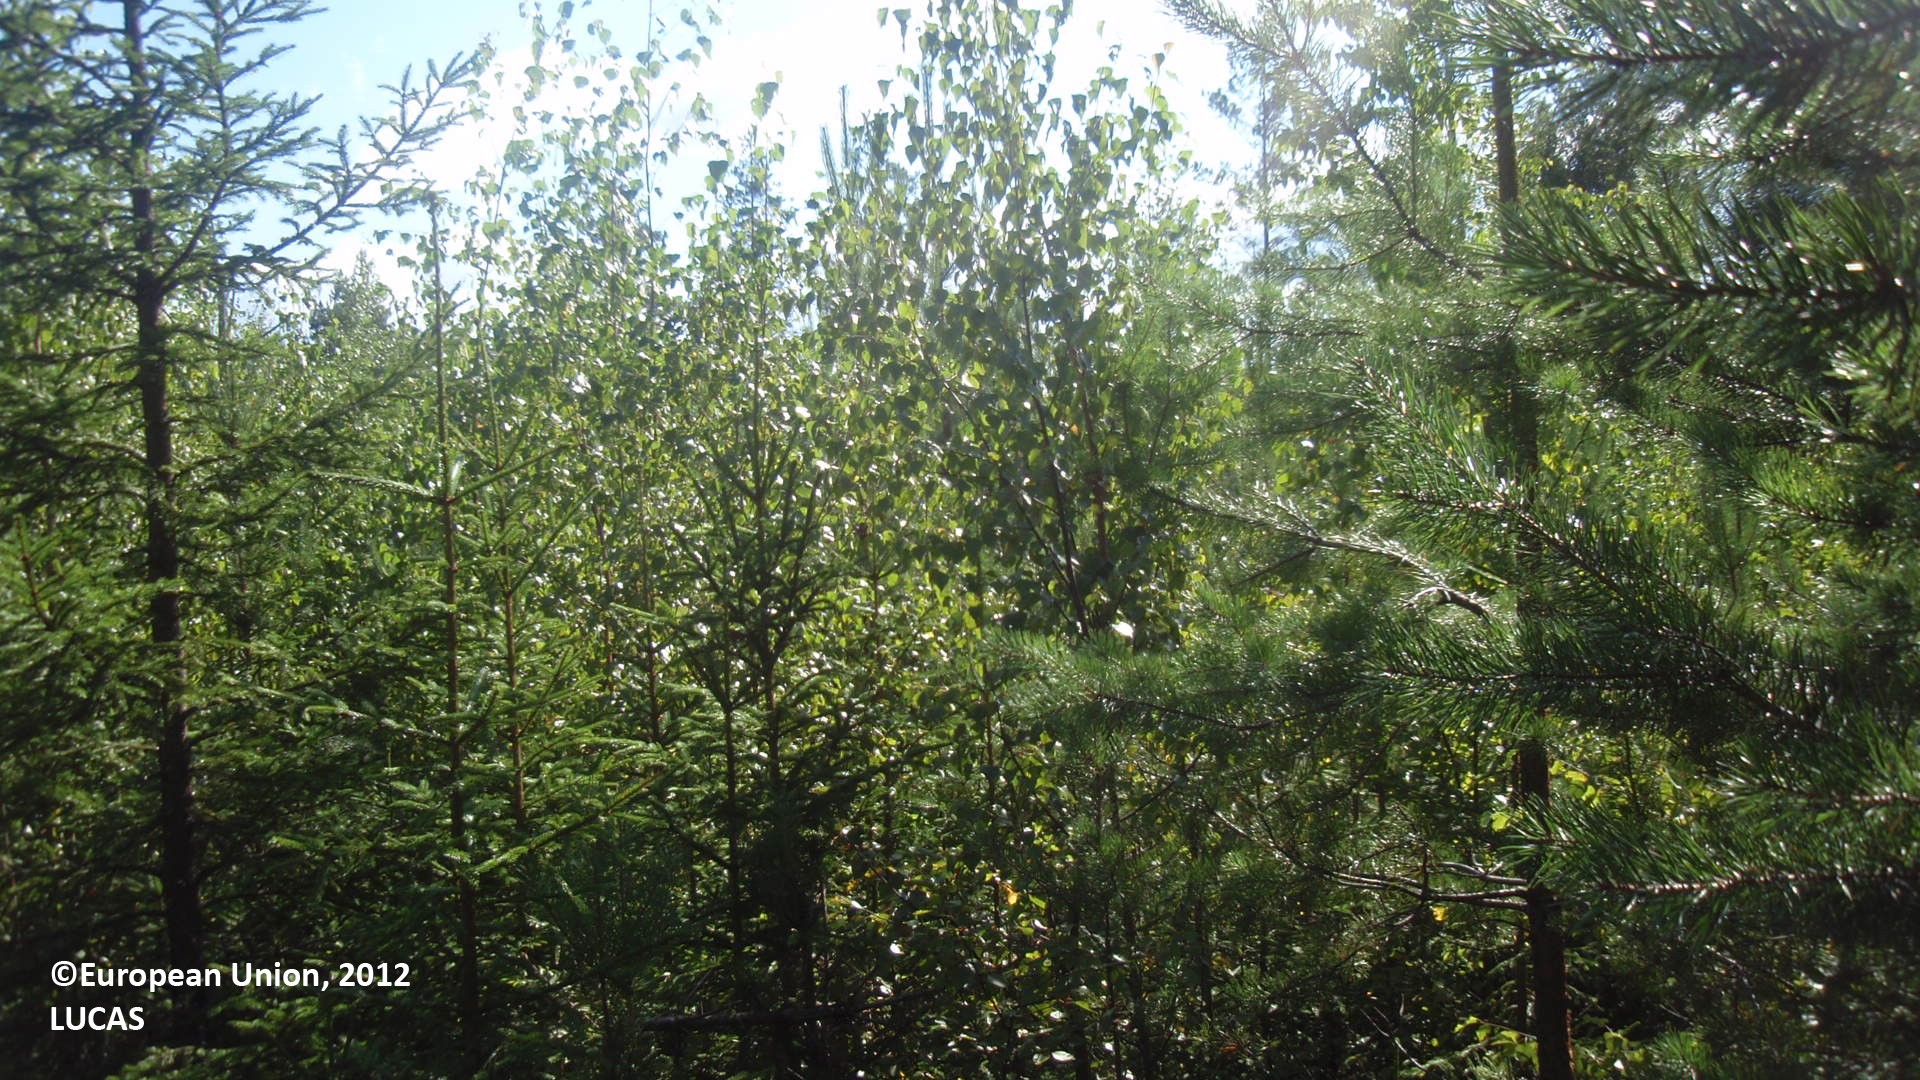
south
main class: Woodland
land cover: Pine dominated mixed woodland
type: boreal forest
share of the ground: 50 - 75 %
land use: Forestry
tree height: > 5 m
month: August
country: FI
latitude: 61.5058
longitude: 27.7547
